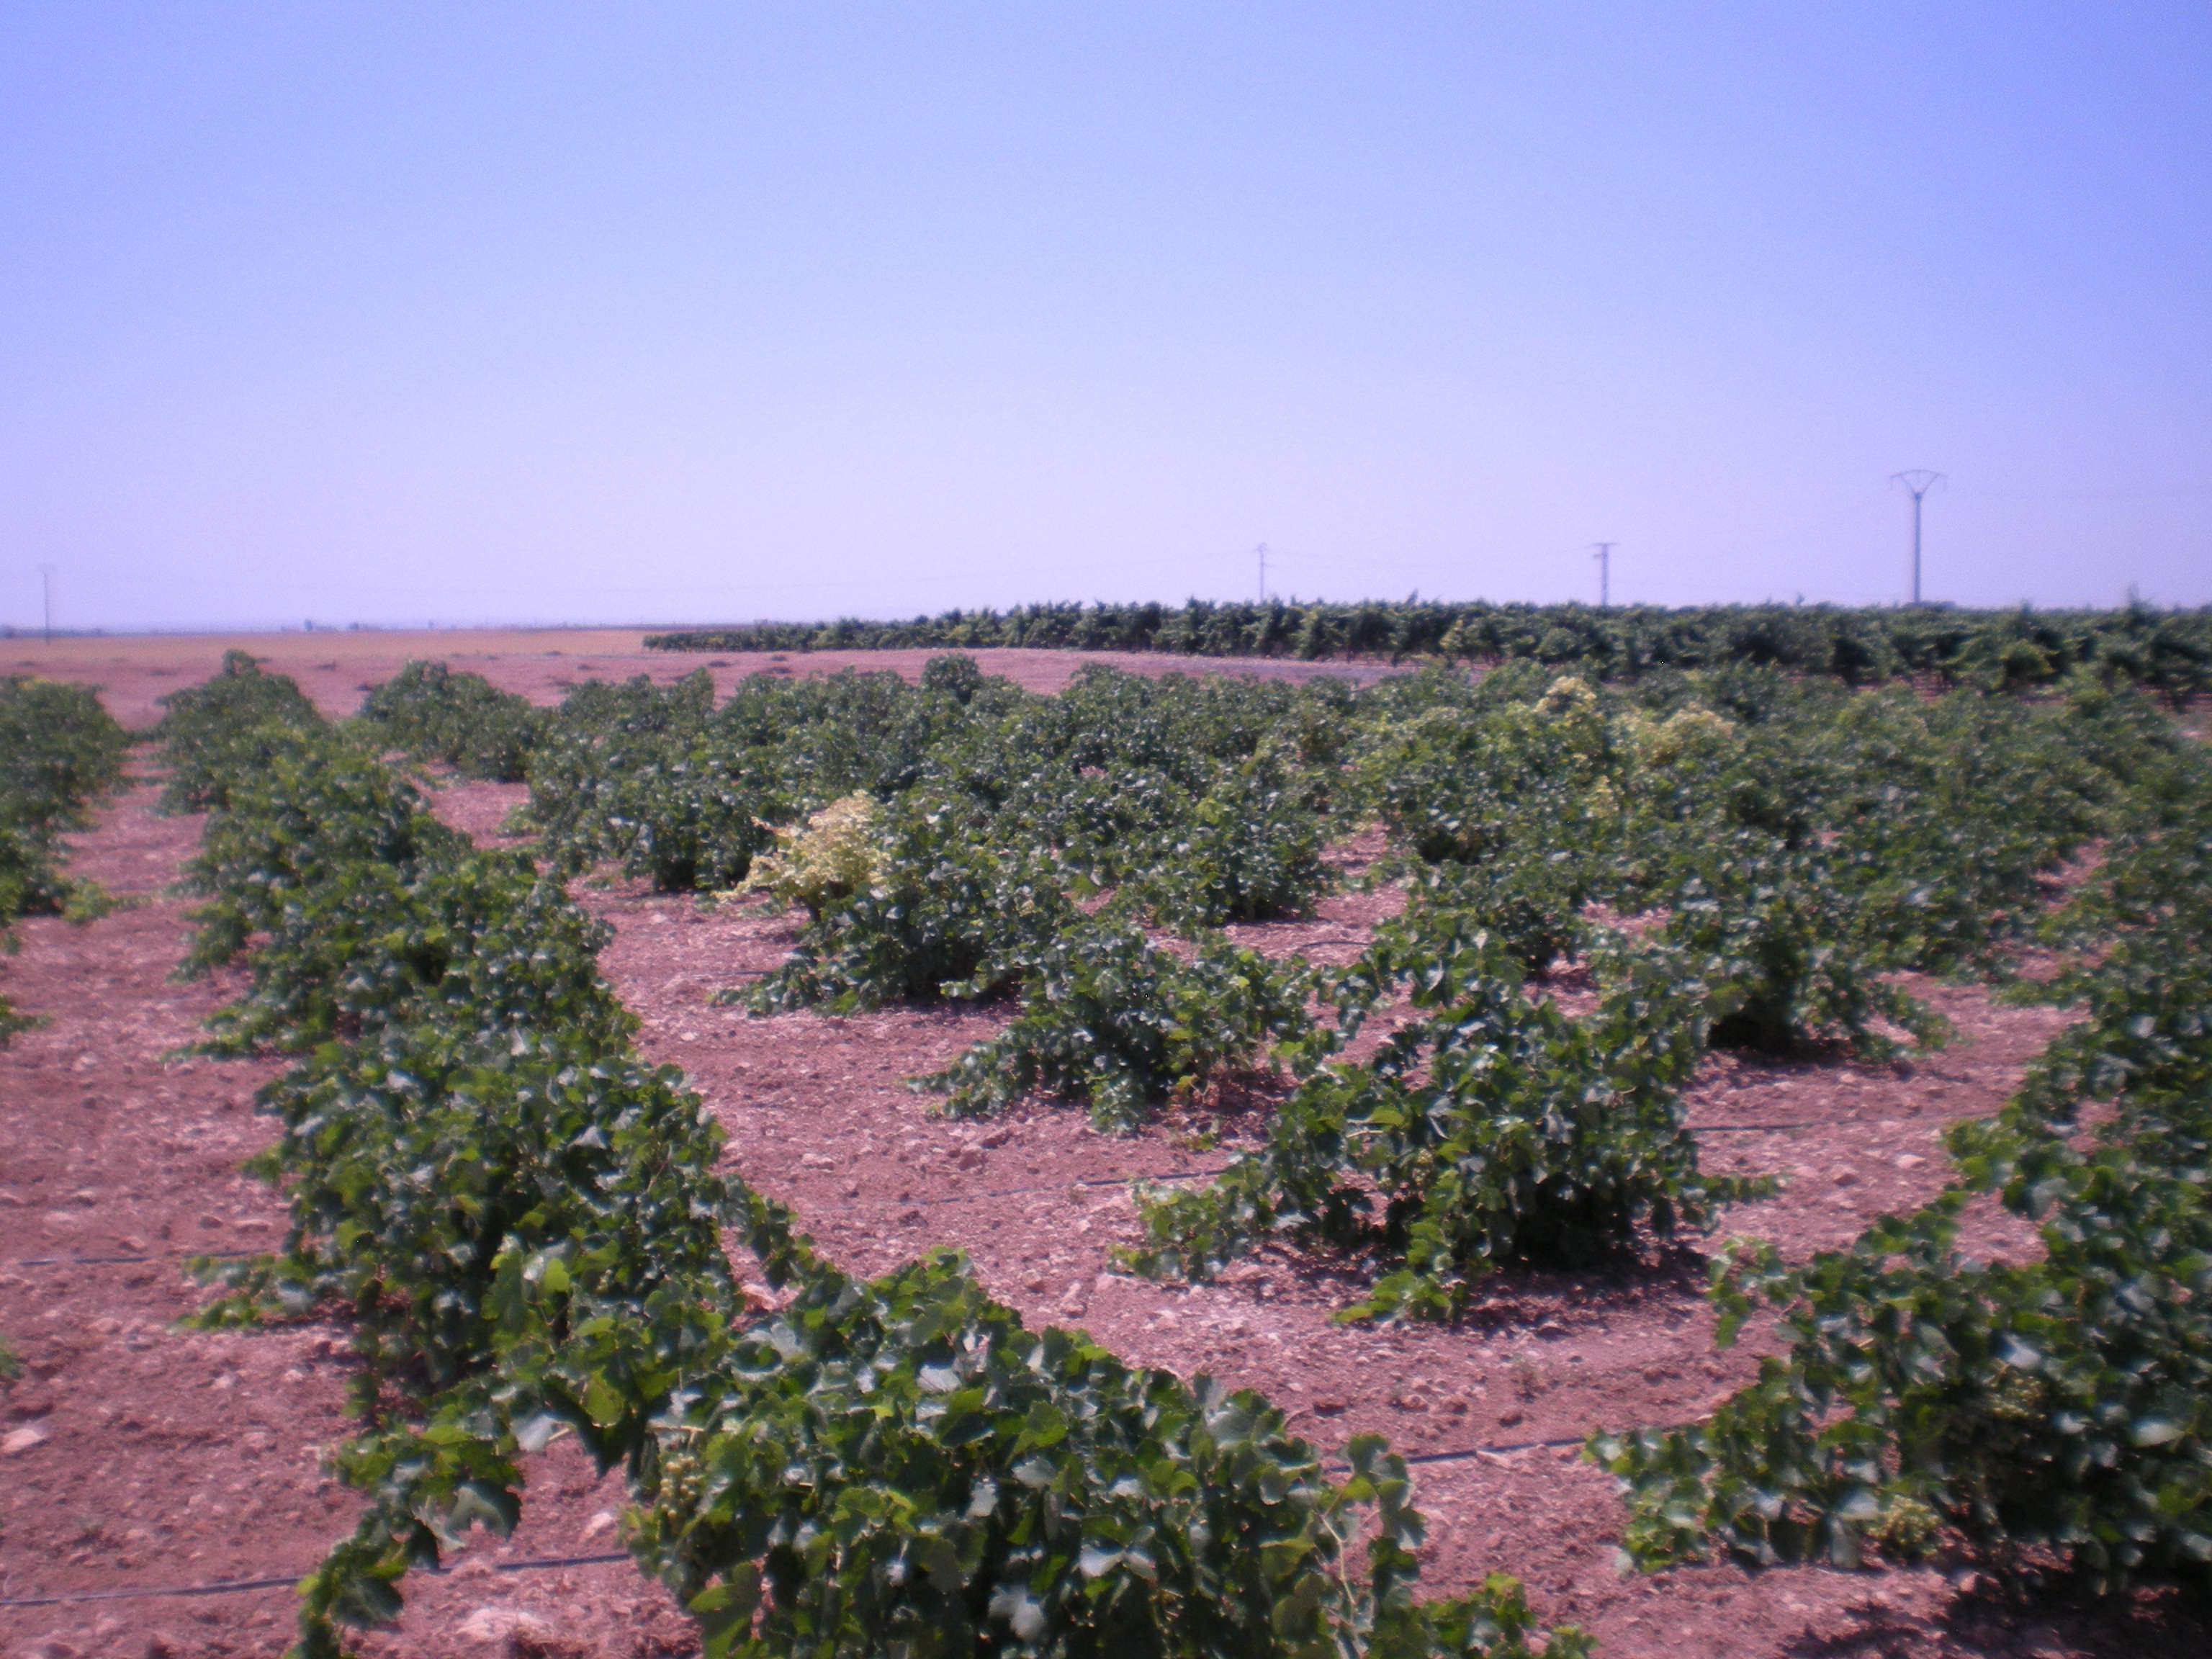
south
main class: Cropland
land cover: Vineyards
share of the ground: 25 - 50 %
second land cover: Other bare soil
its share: > 75 %
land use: Agriculture (excluding fallow land and kitchen gardens)
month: July
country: ES
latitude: 39.2569
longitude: -3.0985
